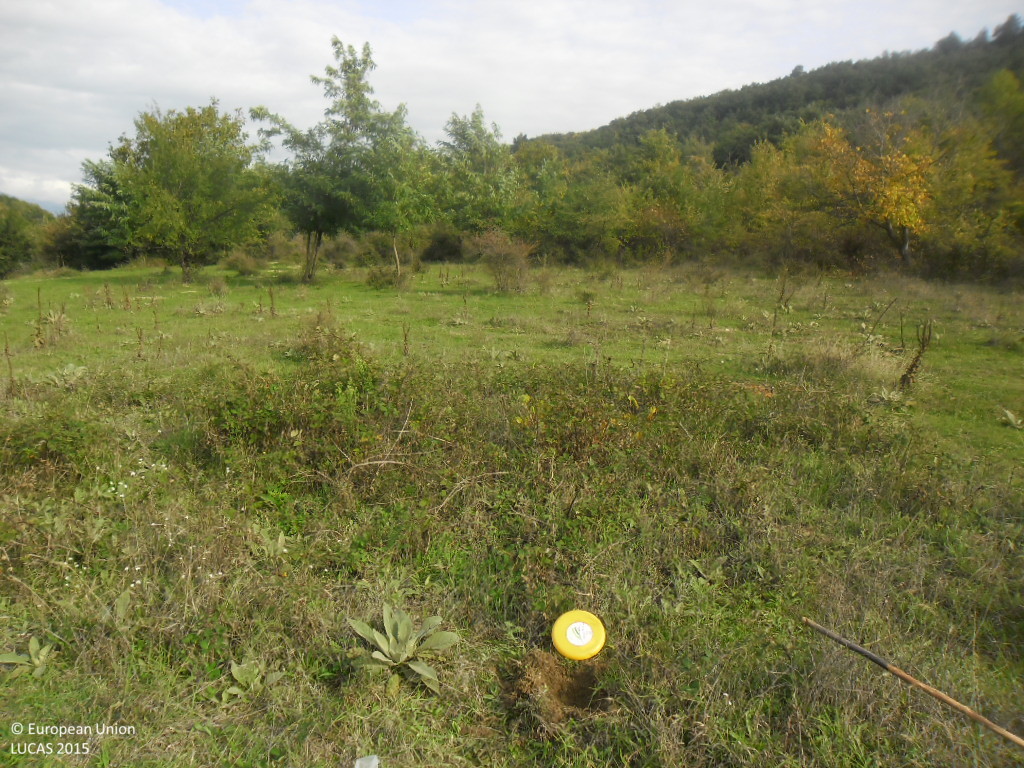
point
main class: Grassland
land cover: Grassland with sparse tree/shrub cover
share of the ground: > 75 %
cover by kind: herbaceous plants 90 %, broadleaved forest trees 5 %, shrubs 5 %
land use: Agriculture (excluding fallow land and kitchen gardens)
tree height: < 5 m
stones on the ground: < 10 %
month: October
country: BG
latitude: 42.0985
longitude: 23.0469
